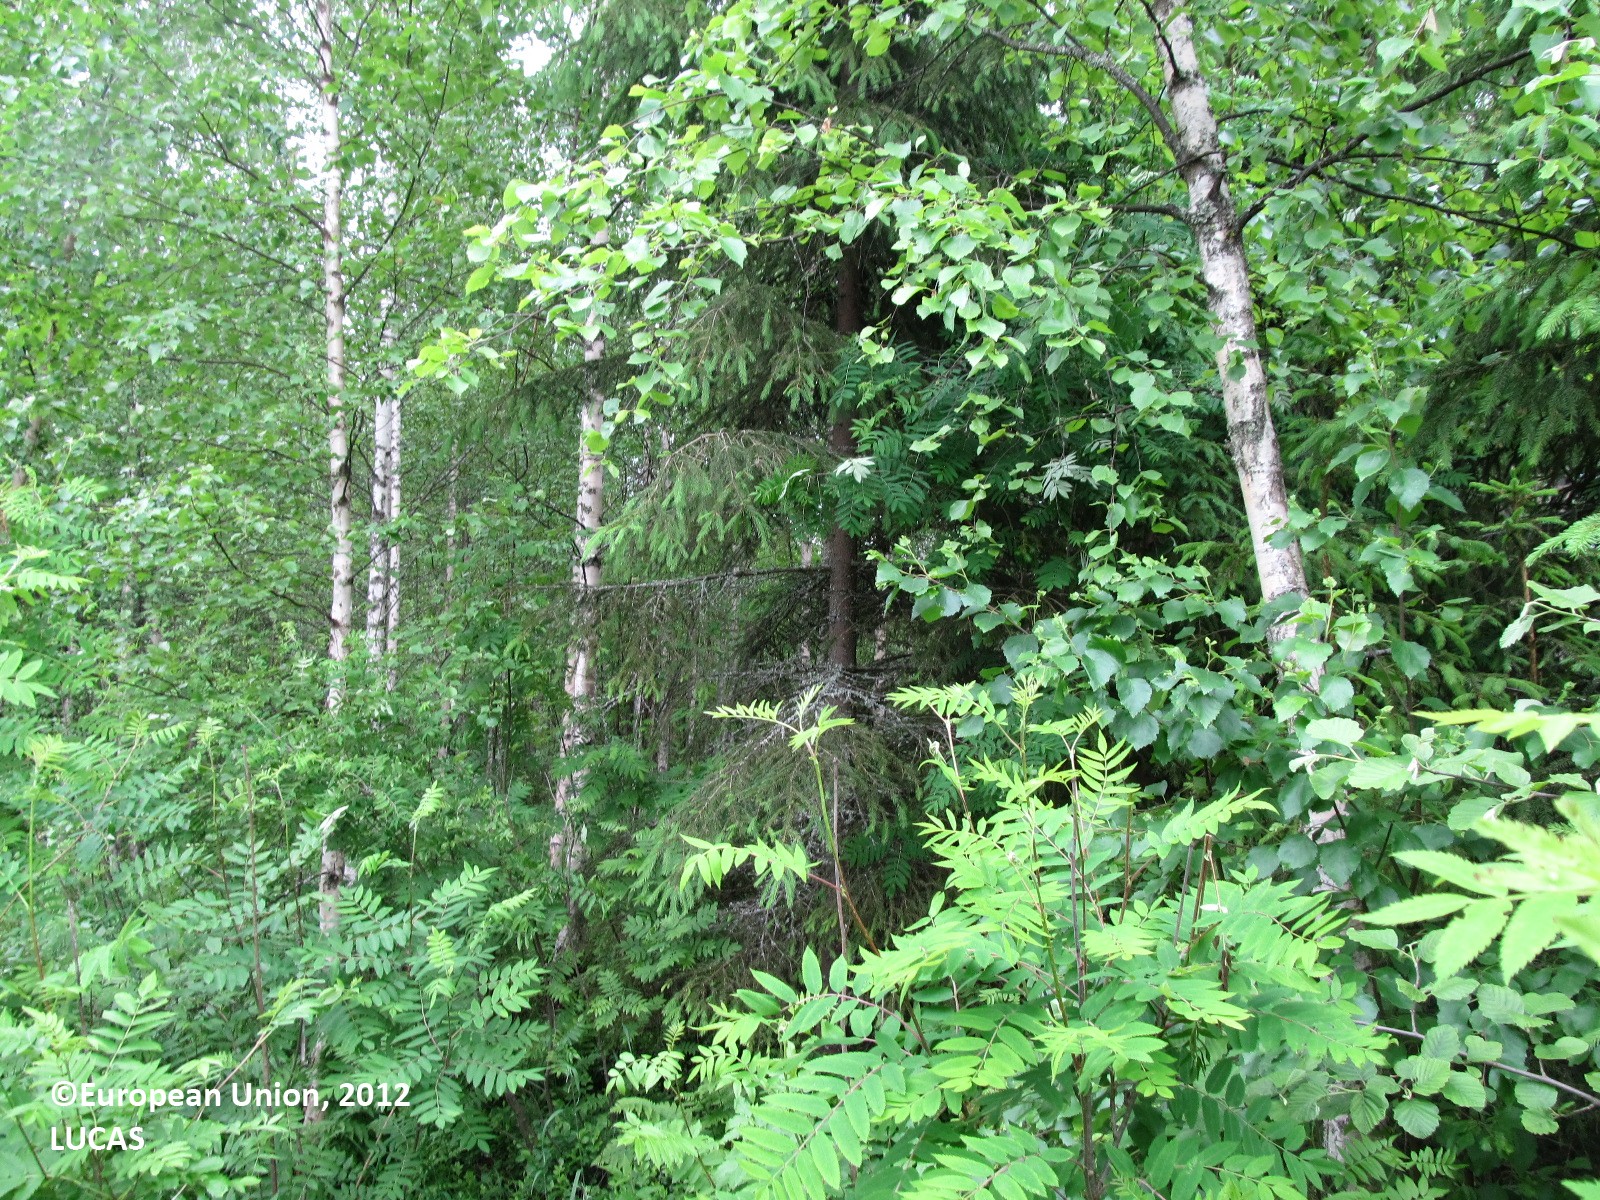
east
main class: Woodland
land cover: Broadleaved woodland
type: boreal forest
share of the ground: 50 - 75 %
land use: Forestry
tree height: < 5 m
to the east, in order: Broadleaved woodland; Spruce dominated coniferous woodland; Grassland with sparse tree/shrub cover; Spruce dominated coniferous woodland; Broadleaved woodland; Spruce dominated coniferous woodland; Ditches and canals; Temporary grasslands; Ditches and canals; Broadleaved woodland
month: June
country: FI
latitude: 63.1886
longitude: 27.6721
